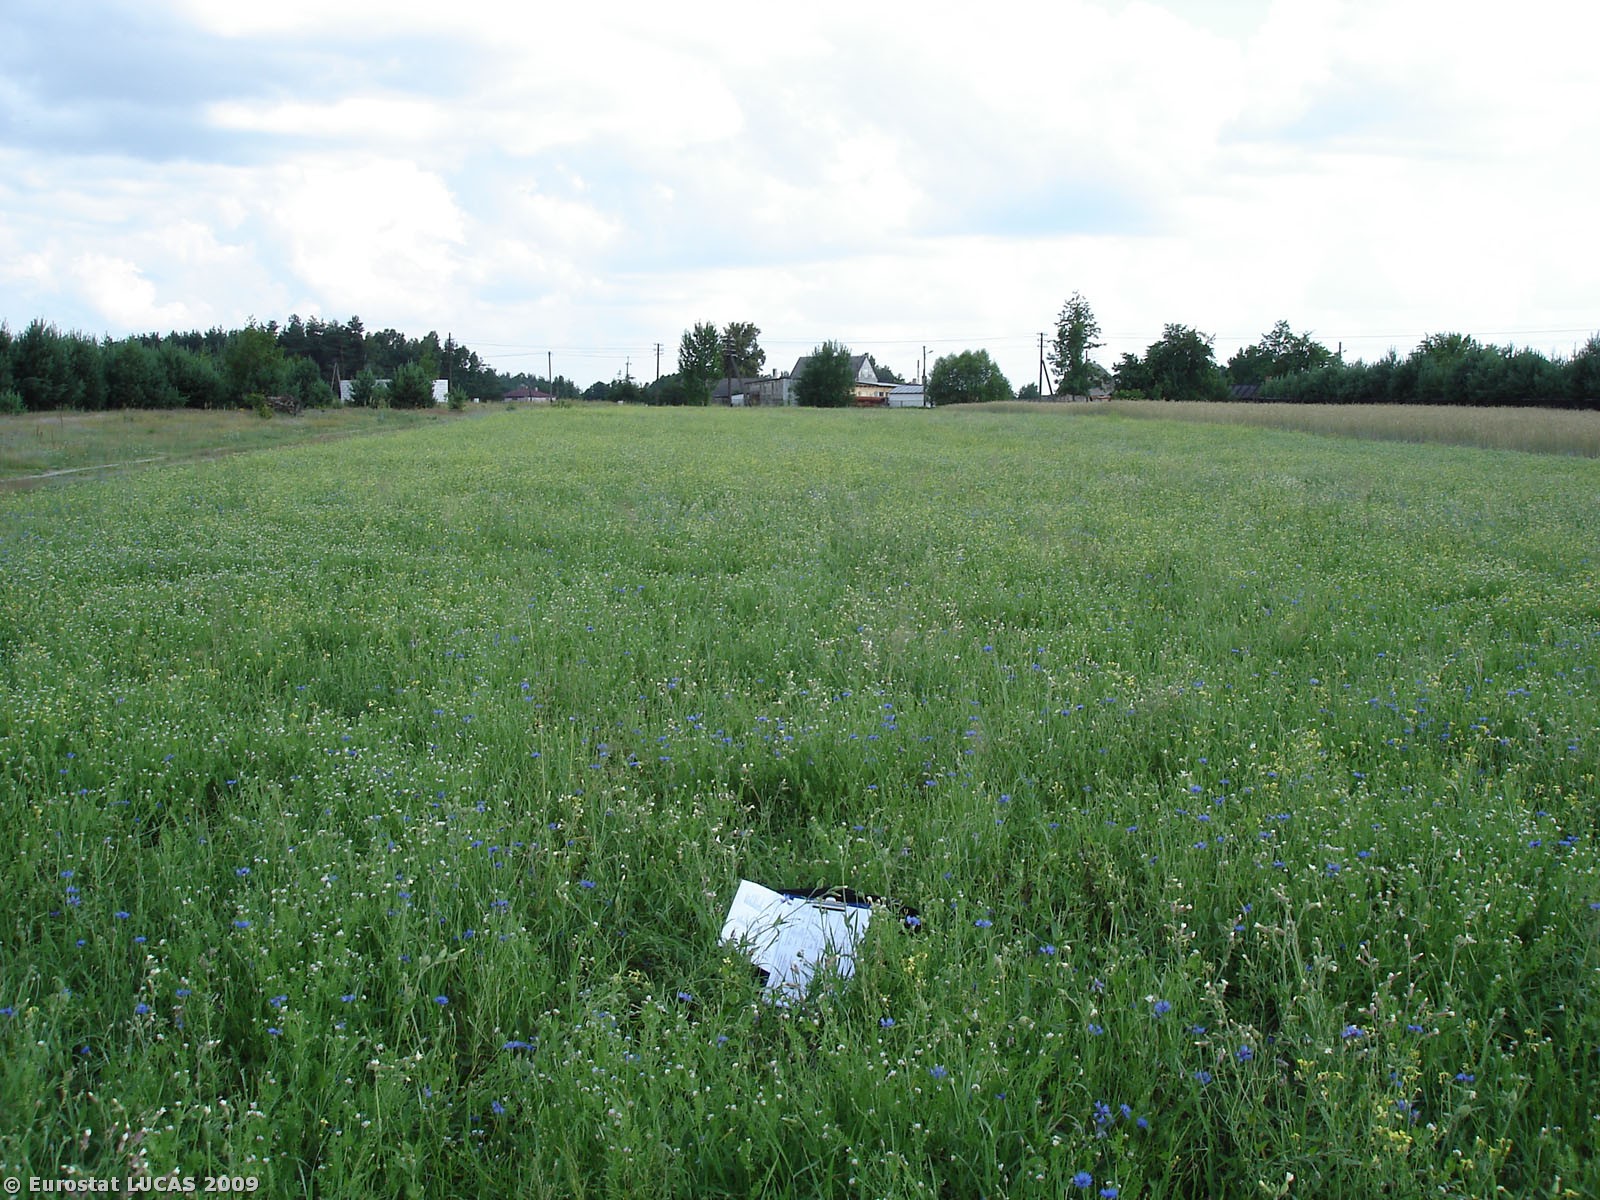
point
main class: Cropland
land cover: Lucerne
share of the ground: > 75 %
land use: Agriculture (excluding fallow land and kitchen gardens)
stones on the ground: < 10 %
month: March
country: PL
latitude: 51.0019
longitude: 19.9073
